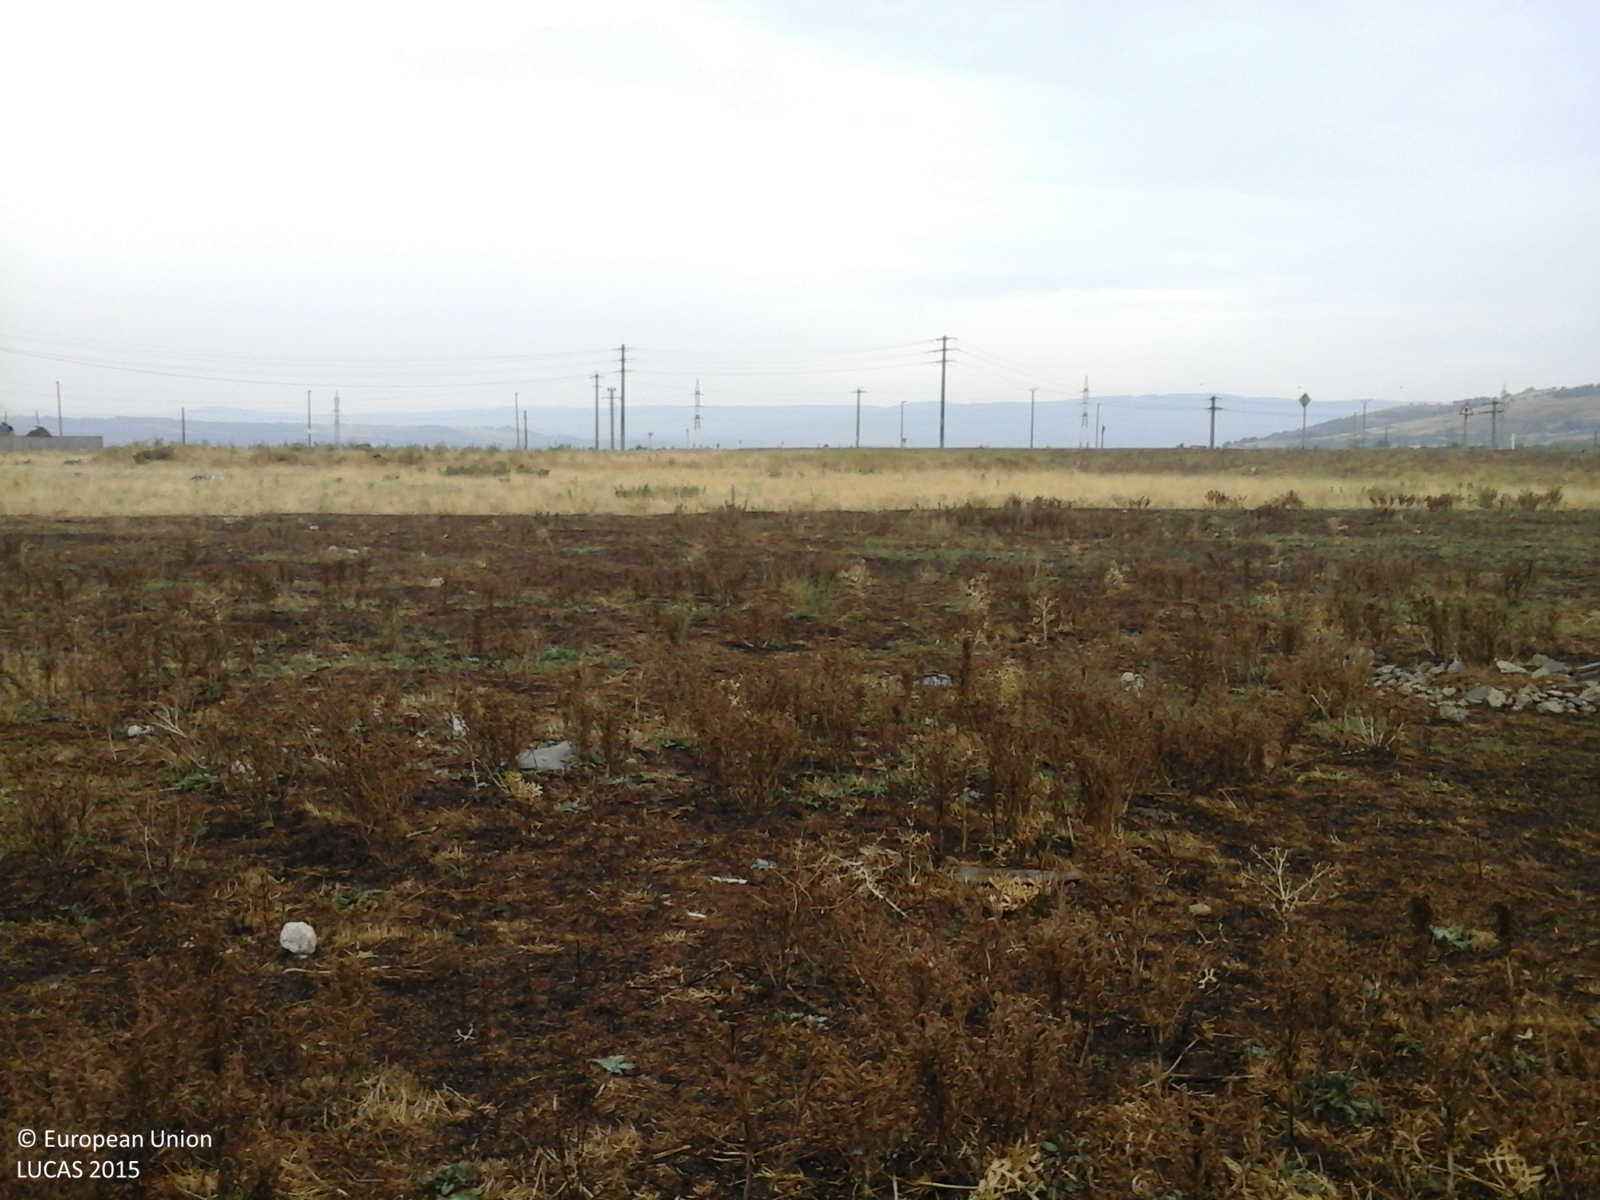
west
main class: Grassland
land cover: Spontaneously vegetated surfaces
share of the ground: 25 - 50 %
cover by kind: herbaceous plants 100 %
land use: Fallow land
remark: Burnt area
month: August
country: RO
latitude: 44.6356
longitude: 22.6093
